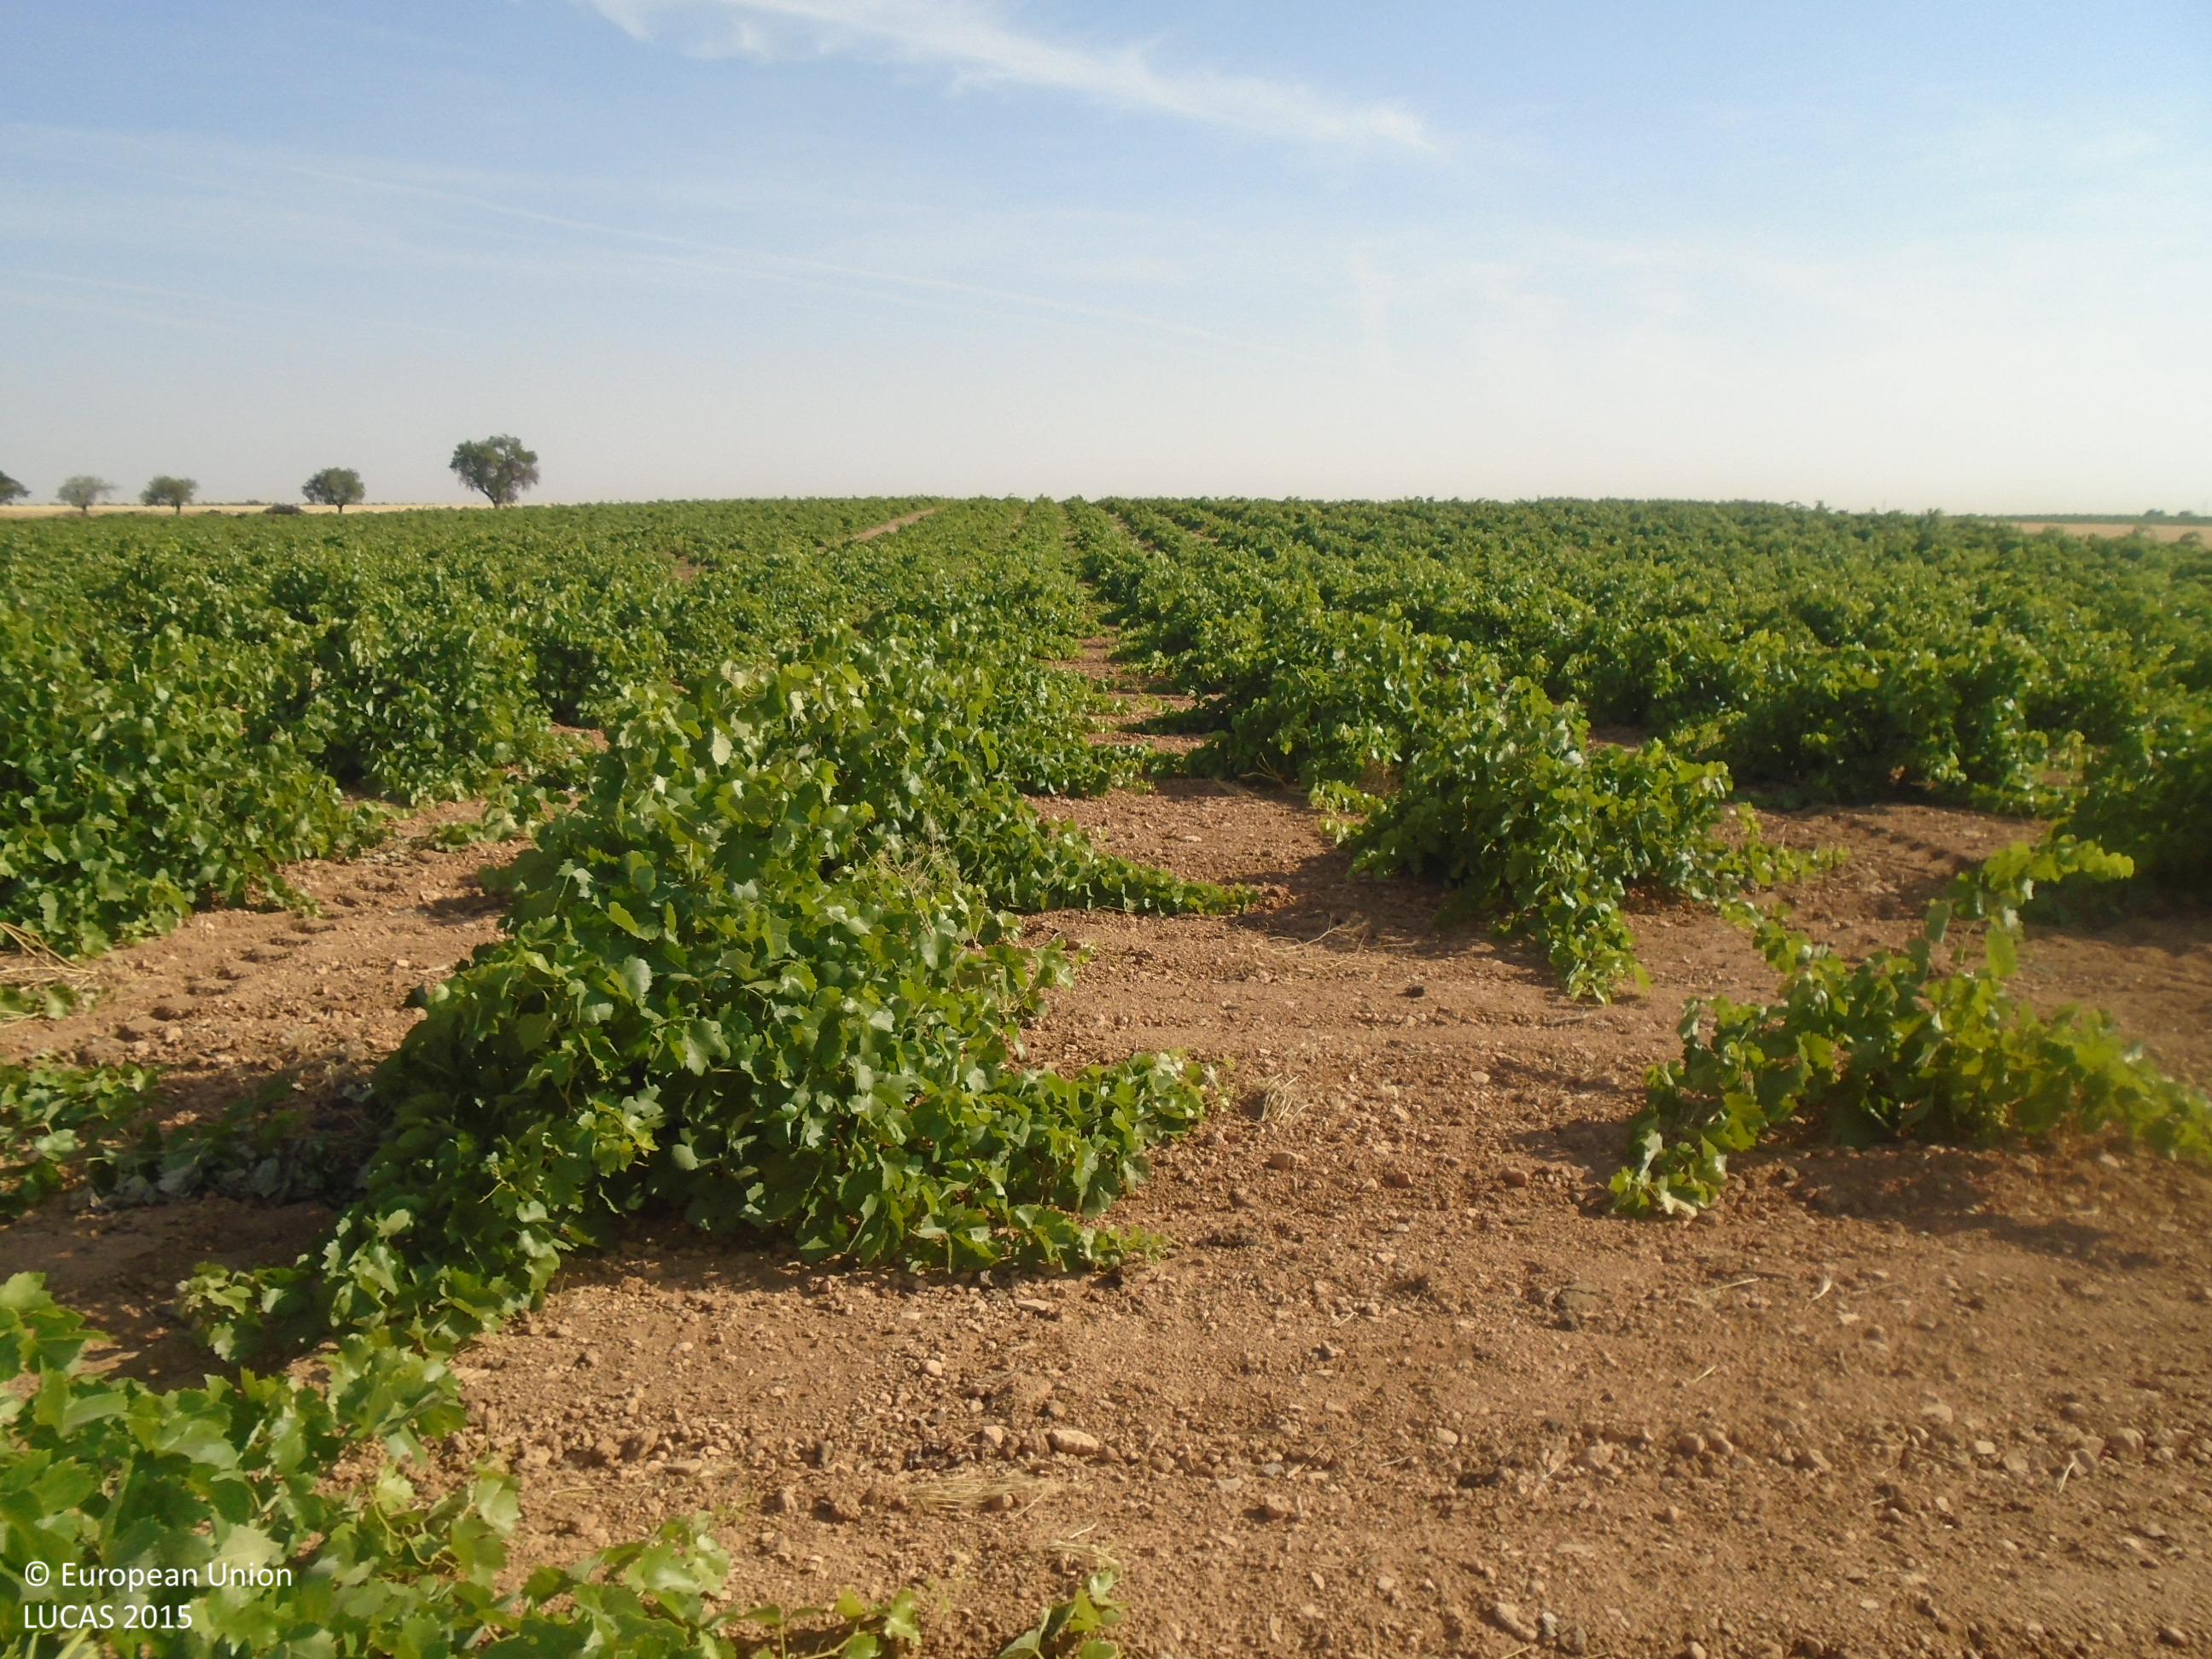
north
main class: Cropland
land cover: Vineyards
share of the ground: 10 - 25 %
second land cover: Other bare soil
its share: > 75 %
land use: Agriculture (excluding fallow land and kitchen gardens)
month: July
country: ES
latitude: 39.3991
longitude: -3.5266
